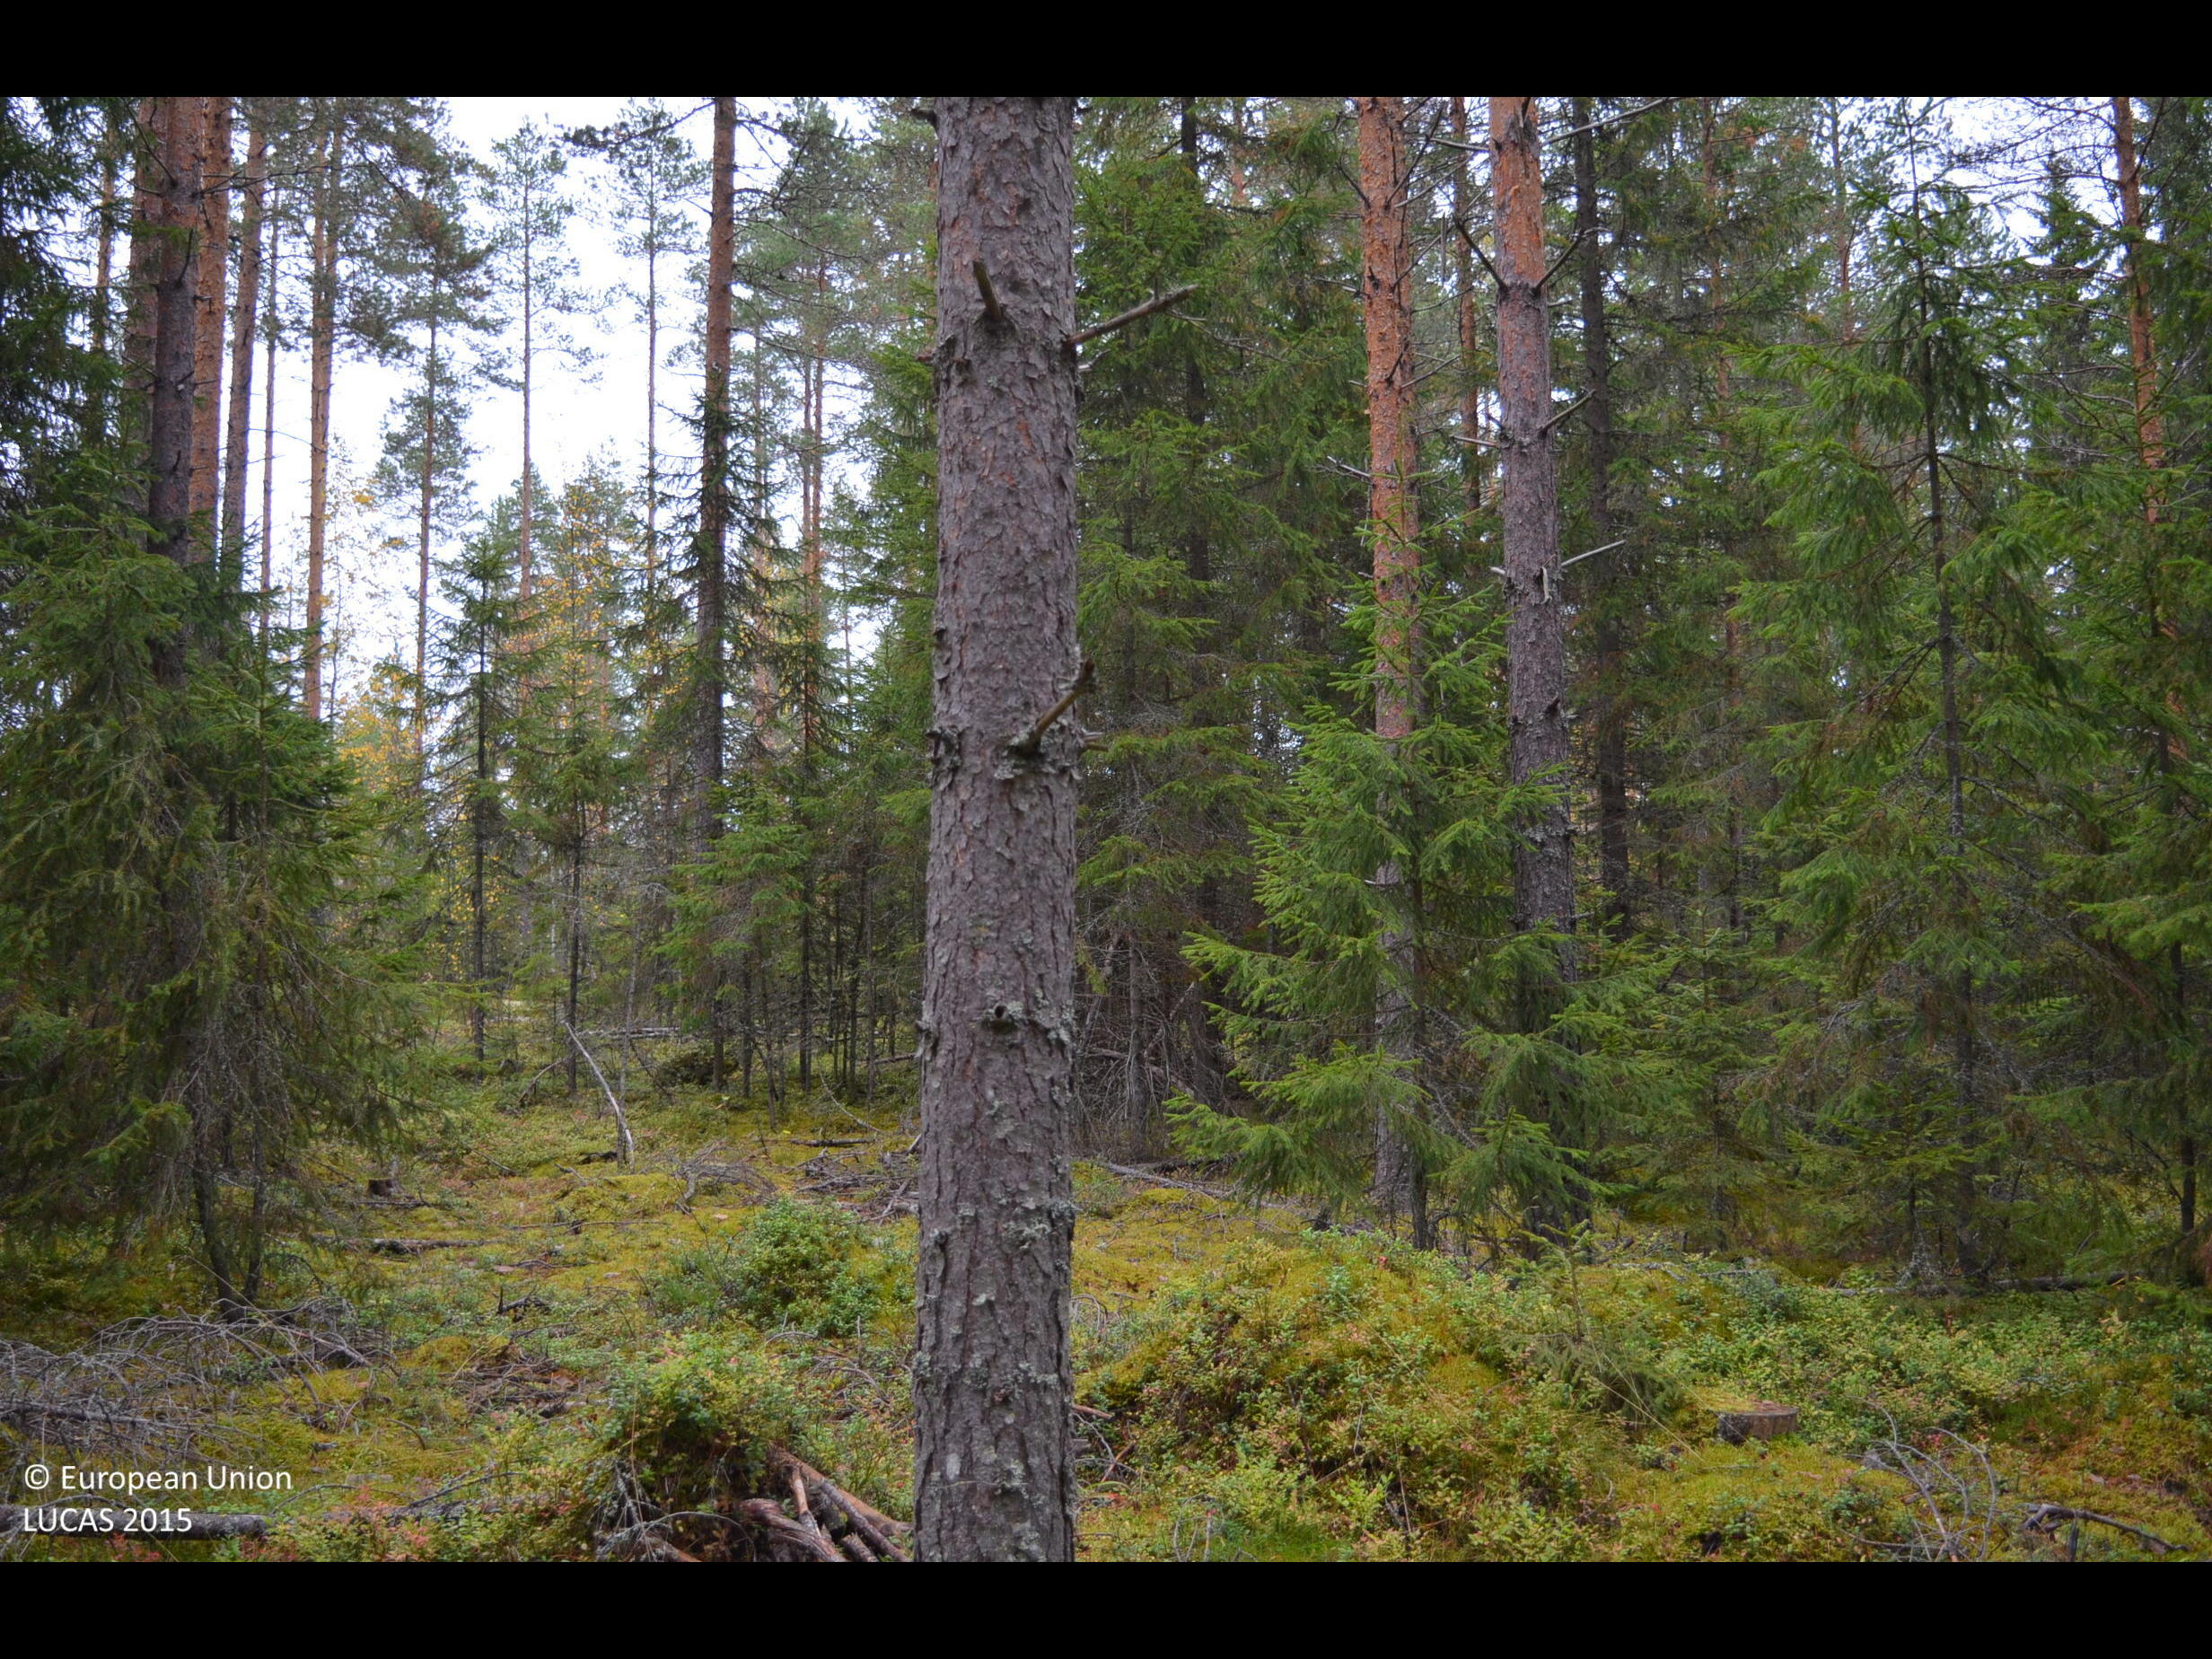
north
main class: Woodland
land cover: Other coniferous woodland
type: boreal forest
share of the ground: 50 - 75 %
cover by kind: coniferous forest trees 70 %, shrubs 20 %, lichens and mosses 10 %
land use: Forestry
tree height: > 5 m
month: September
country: FI
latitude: 62.4978
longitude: 23.6814
